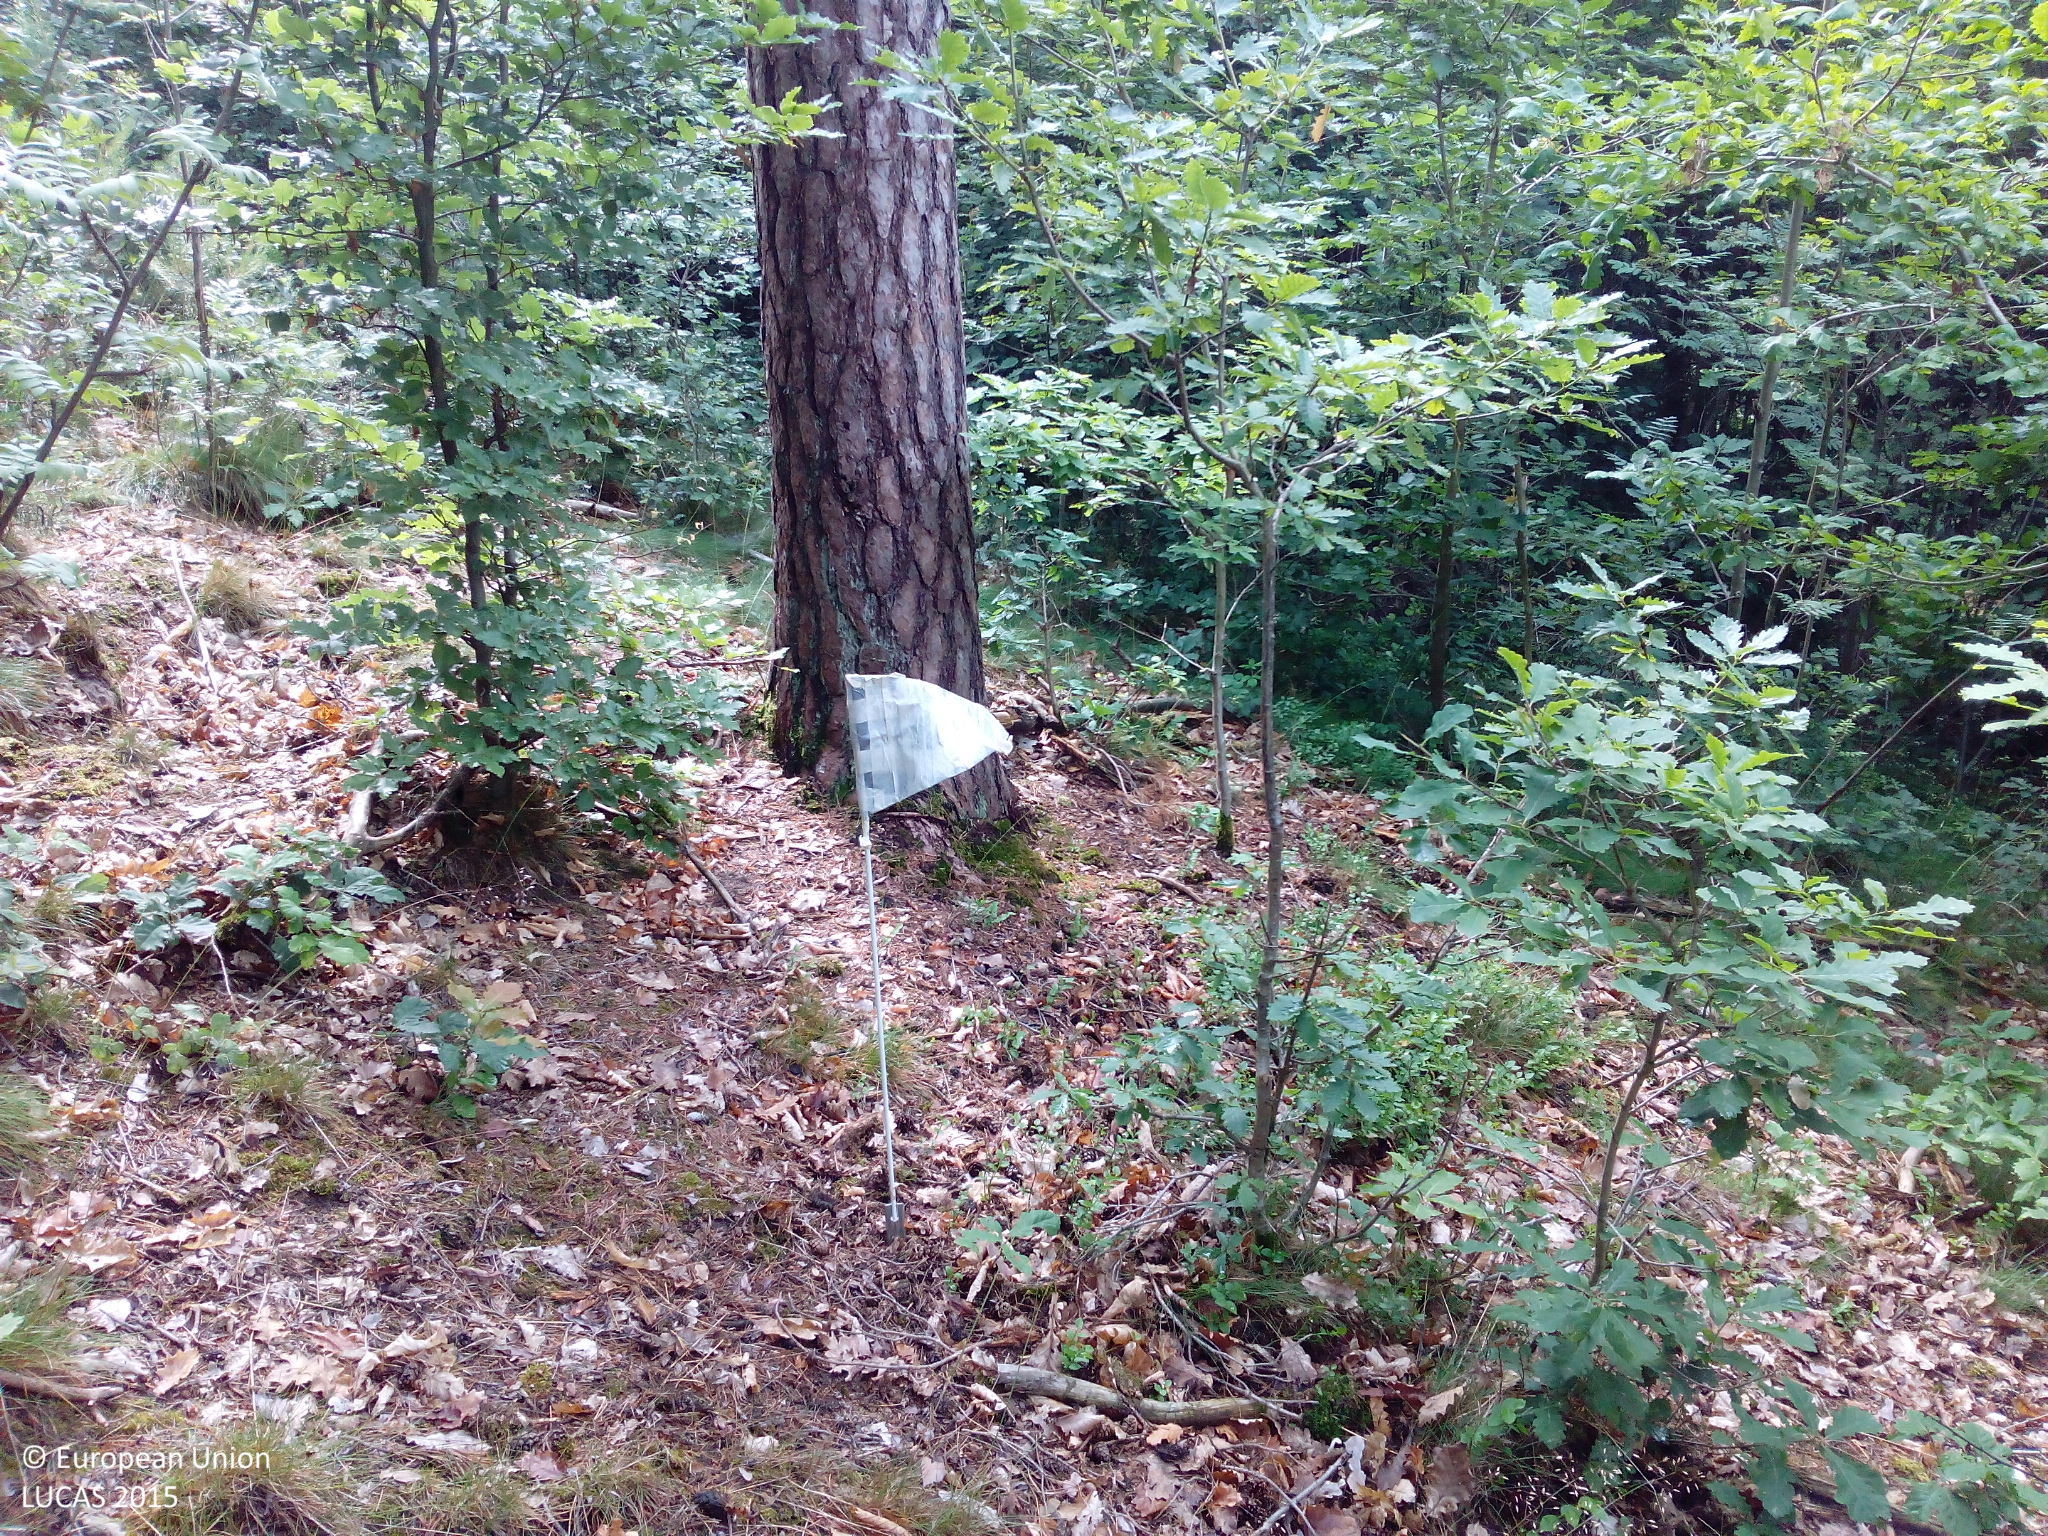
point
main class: Woodland
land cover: Pine dominated mixed woodland
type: hemiboreal forest and nemoral coniferous forest and mixed broadleaved-coniferous forest
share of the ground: > 75 %
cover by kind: broadleaved forest trees 45 %, coniferous forest trees 40 %, herbaceous plants 5 %, lichens and mosses 5 %, unconsolidated bare surface 5 %
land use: Forestry
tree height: > 5 m
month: June
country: DE
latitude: 49.1196
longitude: 10.8902
